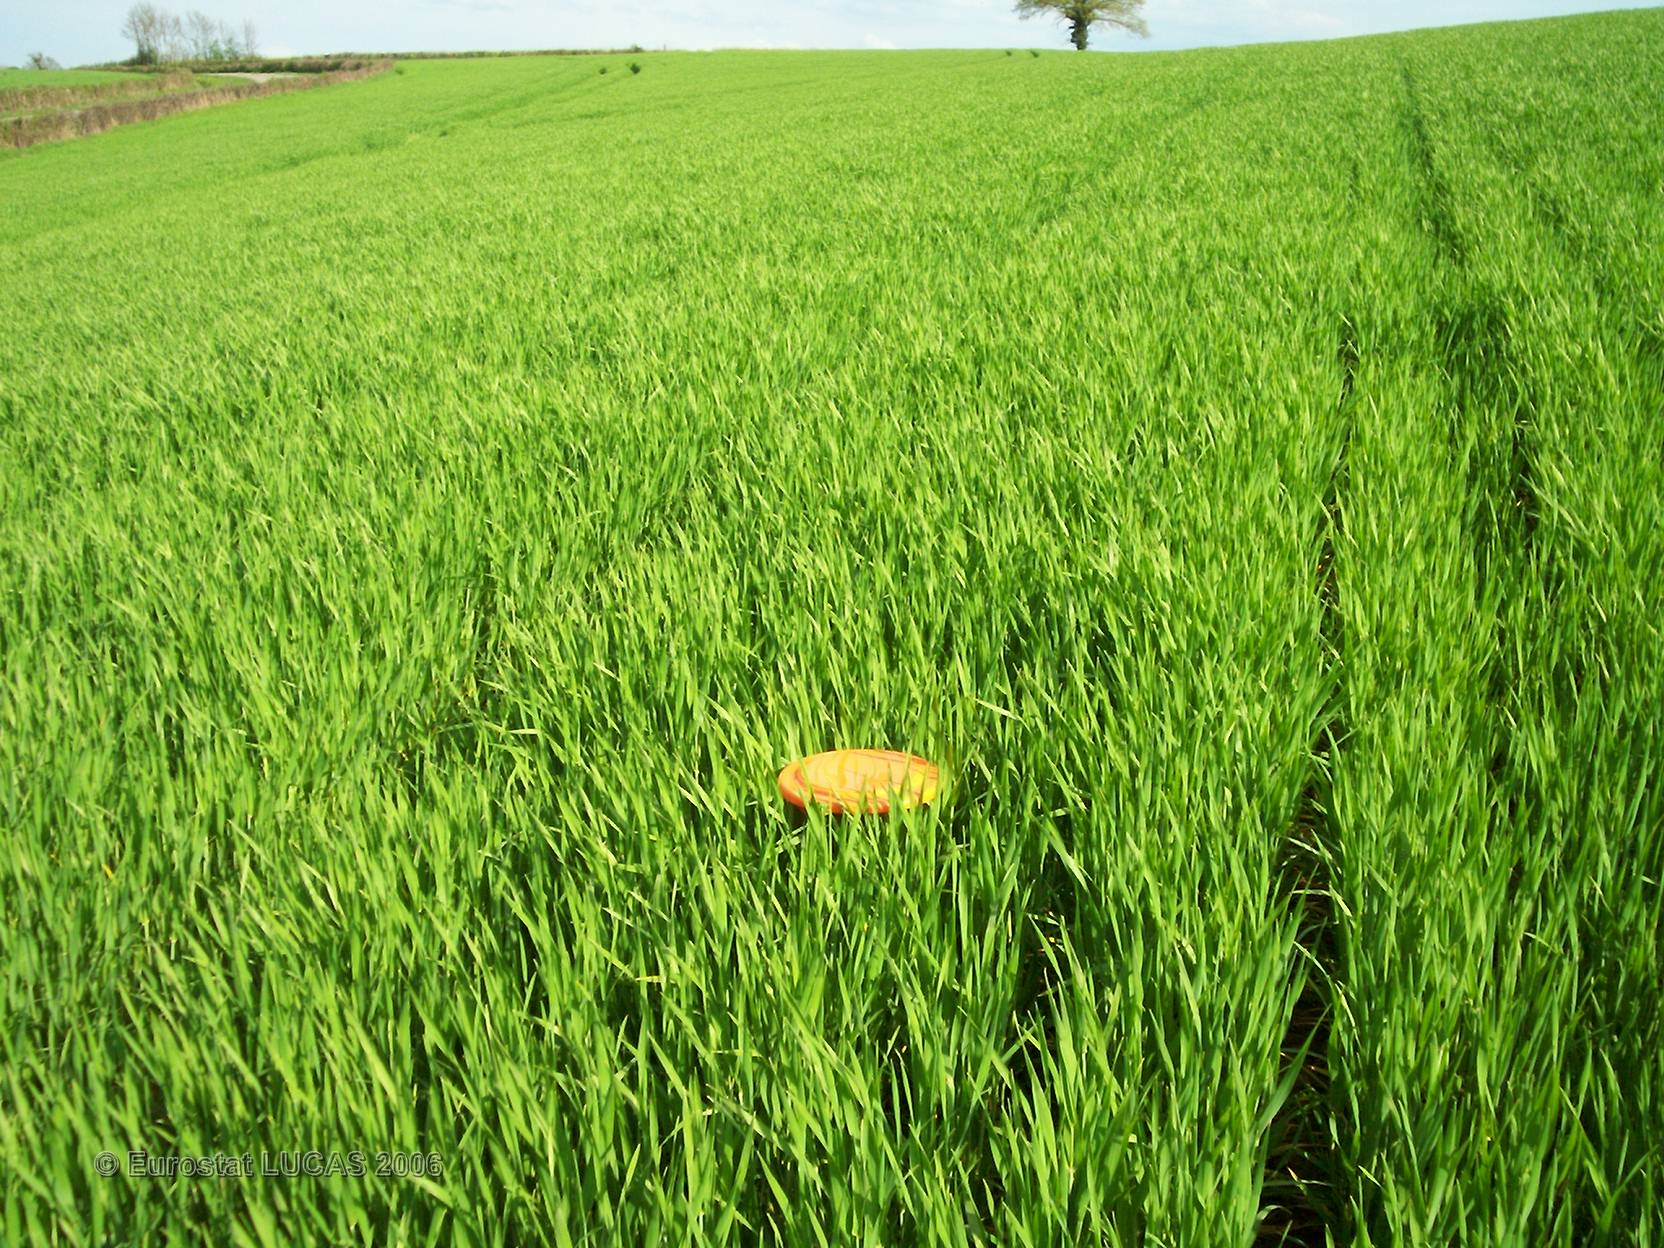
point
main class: Cropland
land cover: Barley
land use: Agriculture (excluding fallow land and kitchen gardens)
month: April
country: FR
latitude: 46.6172
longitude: 1.5933
